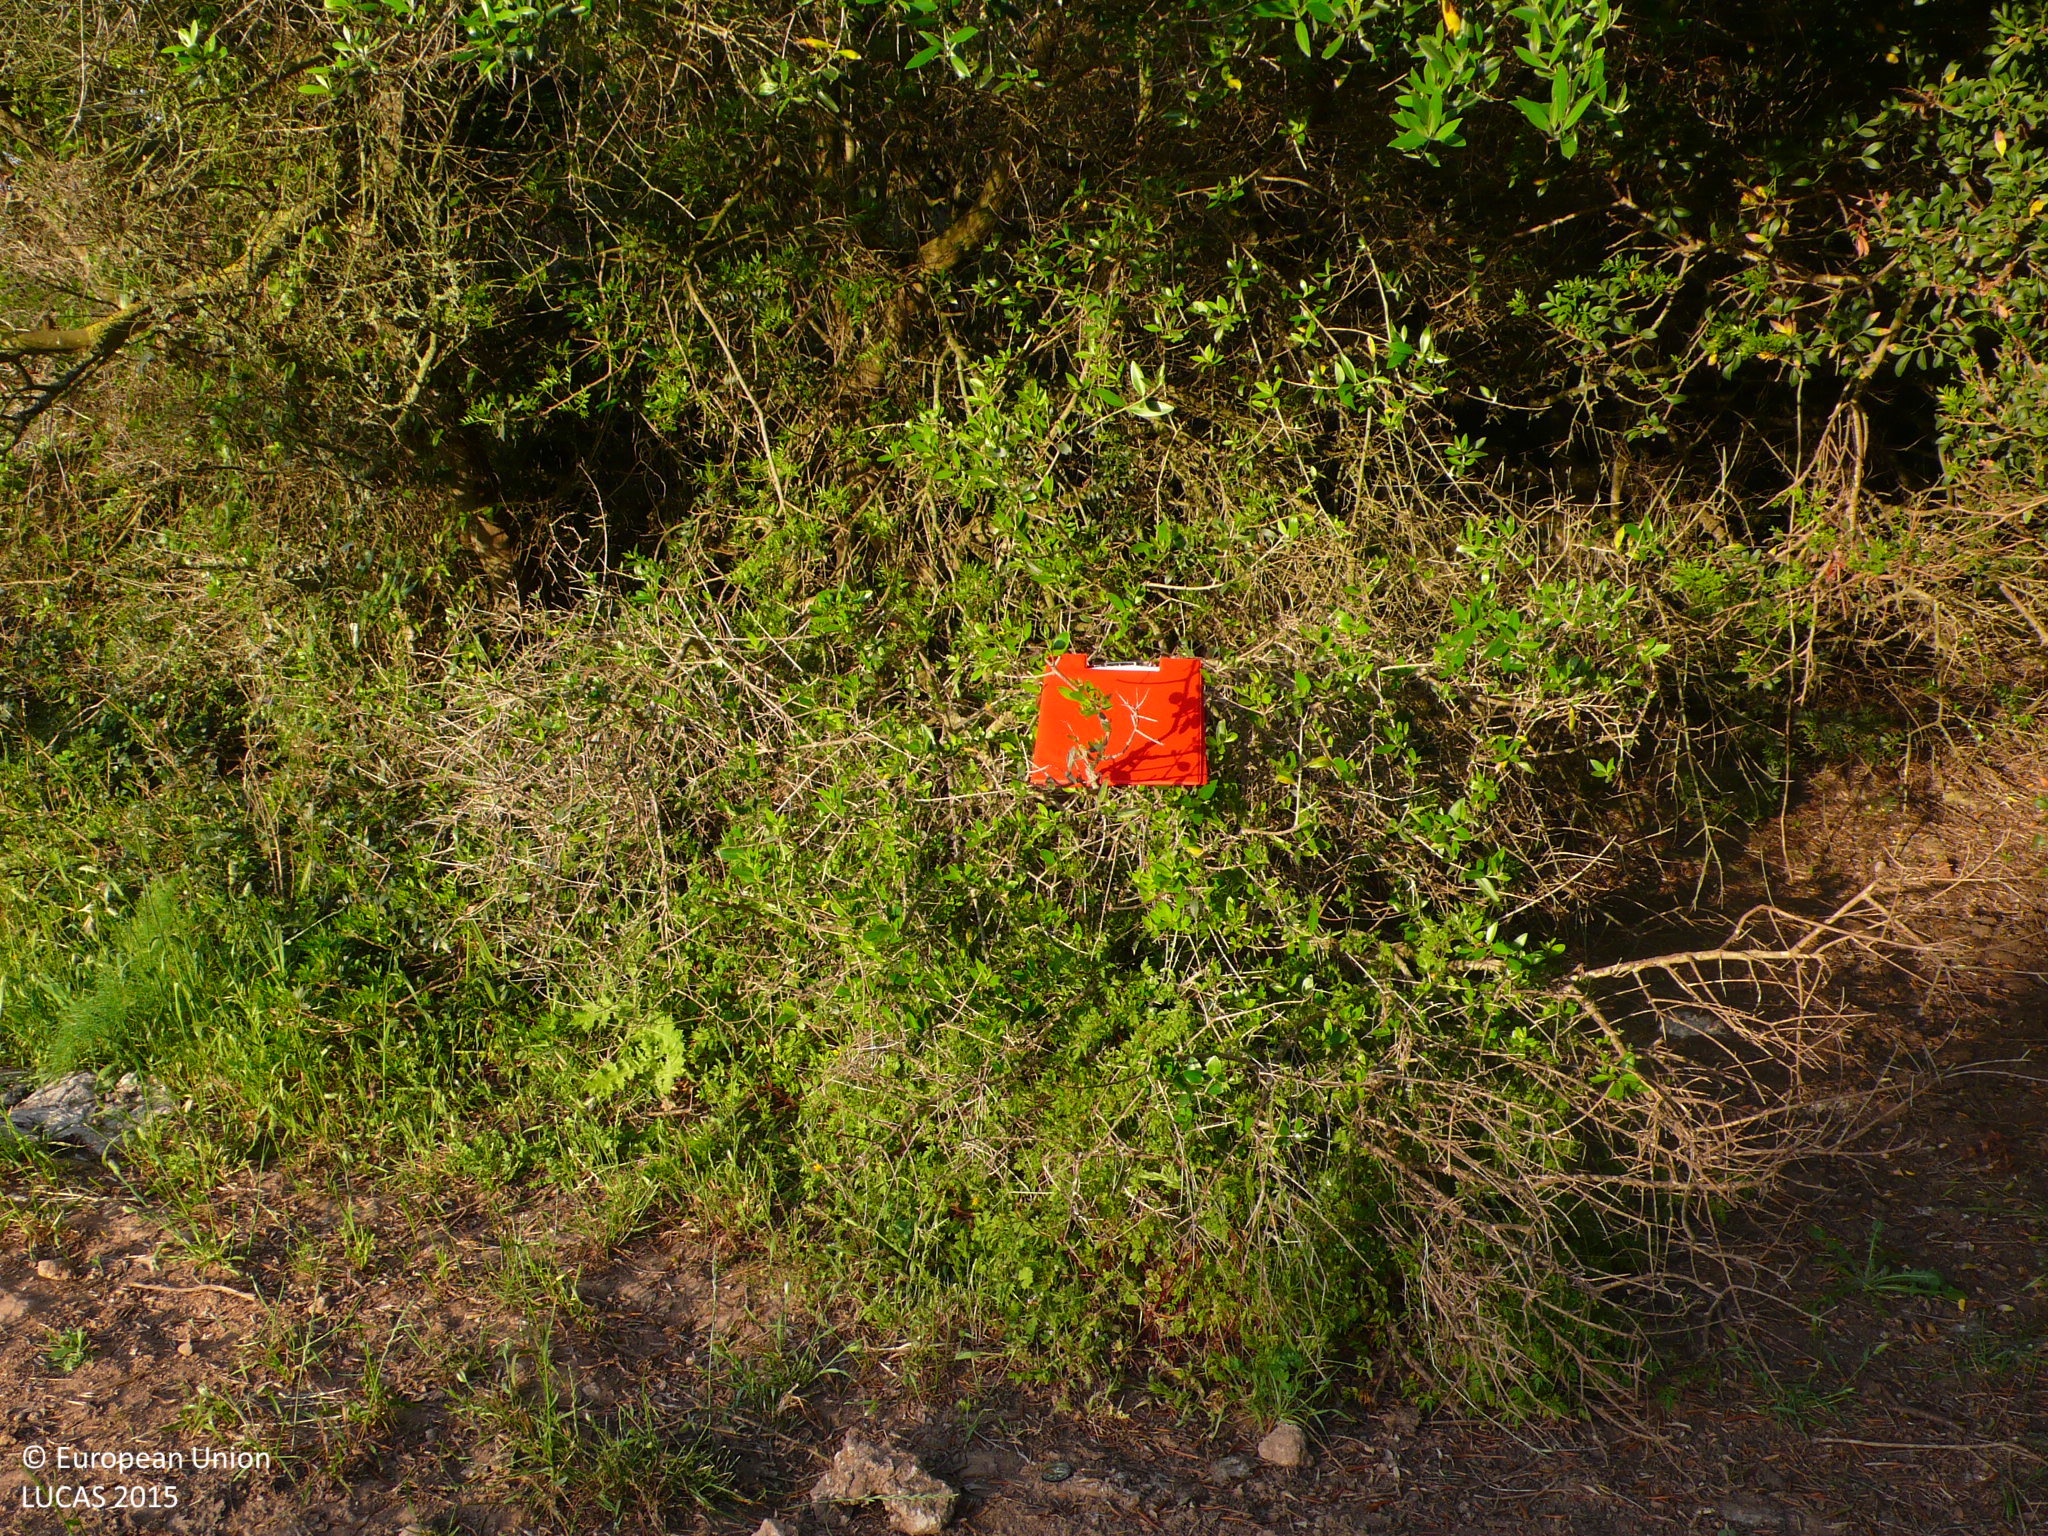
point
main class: Woodland
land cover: Broadleaved woodland
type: broadleaved evergreen forest
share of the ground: 50 - 75 %
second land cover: Grassland without tree/shrub cover
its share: > 75 %
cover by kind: broadleaved forest trees 60 %, shrubs 20 %, herbaceous plants 20 %
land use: Forestry
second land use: Agriculture (excluding fallow land and kitchen gardens)
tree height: > 5 m
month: May
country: ES
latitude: 39.9135
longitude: 4.1885
